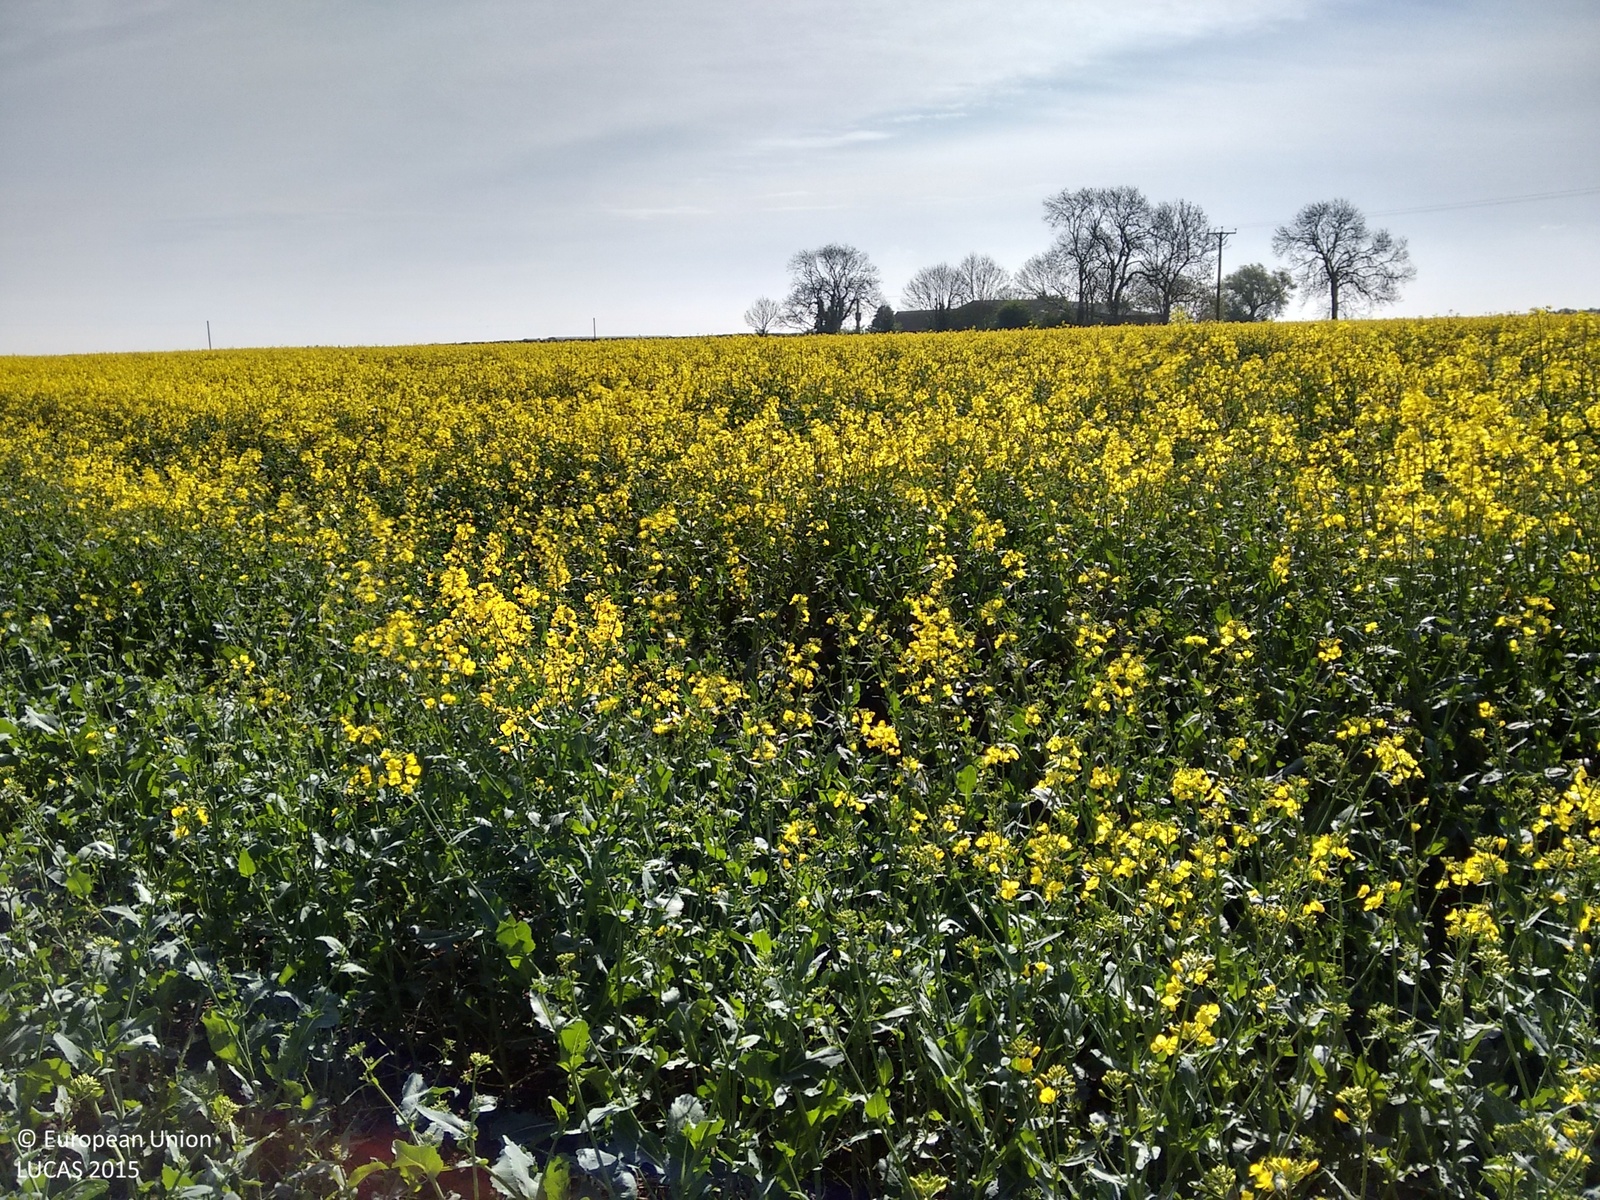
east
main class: Cropland
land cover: Rape and turnip rape
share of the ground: > 75 %
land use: Agriculture (excluding fallow land and kitchen gardens)
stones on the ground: < 10 %
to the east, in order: Rape and turnip rape; Electric lines; Rape and turnip rape; Grass margins; Single bushes/trees; Artificial constructions in urban areas; Grassland without tree/shrub cover
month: May
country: GB
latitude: 53.2403
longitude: 0.2157
